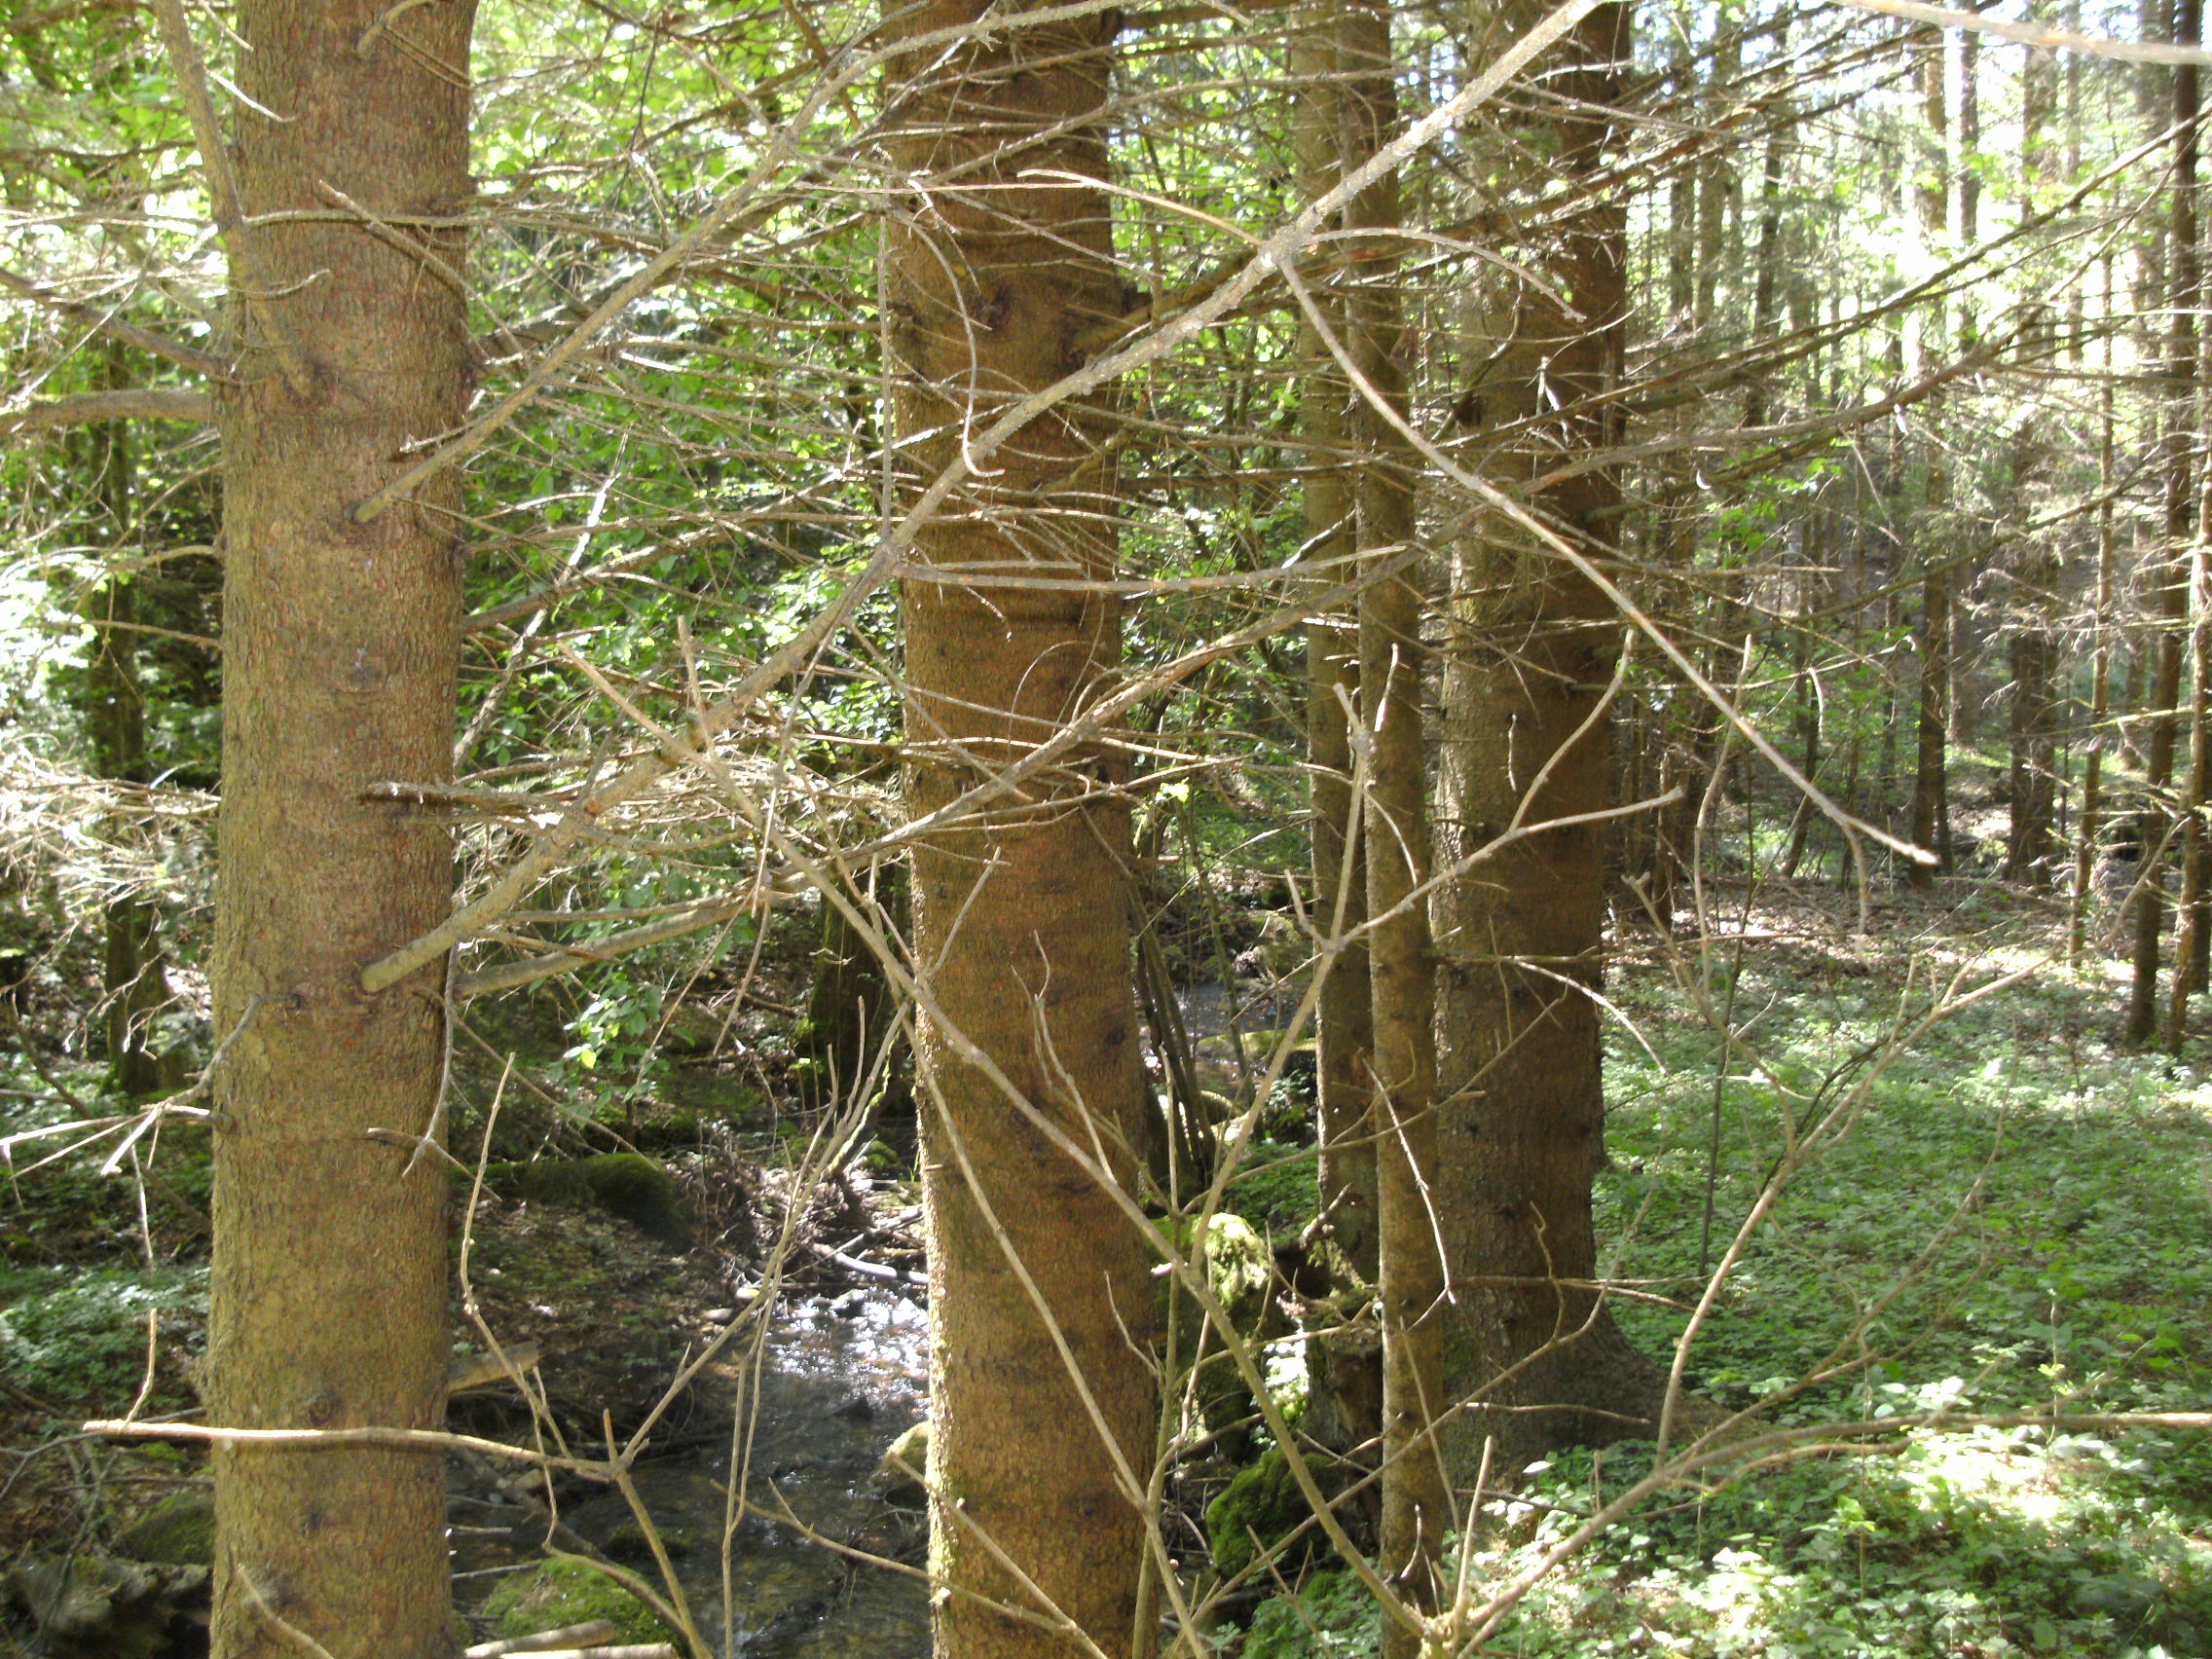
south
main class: Woodland
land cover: Spruce dominated coniferous woodland
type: hemiboreal forest and nemoral coniferous forest and mixed broadleaved-coniferous forest
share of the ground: > 75 %
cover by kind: coniferous forest trees 90 %, broadleaved forest trees 5 %, herbaceous plants 5 %
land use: Forestry
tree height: > 5 m
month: May
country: AT
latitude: 48.5263
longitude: 13.5608
